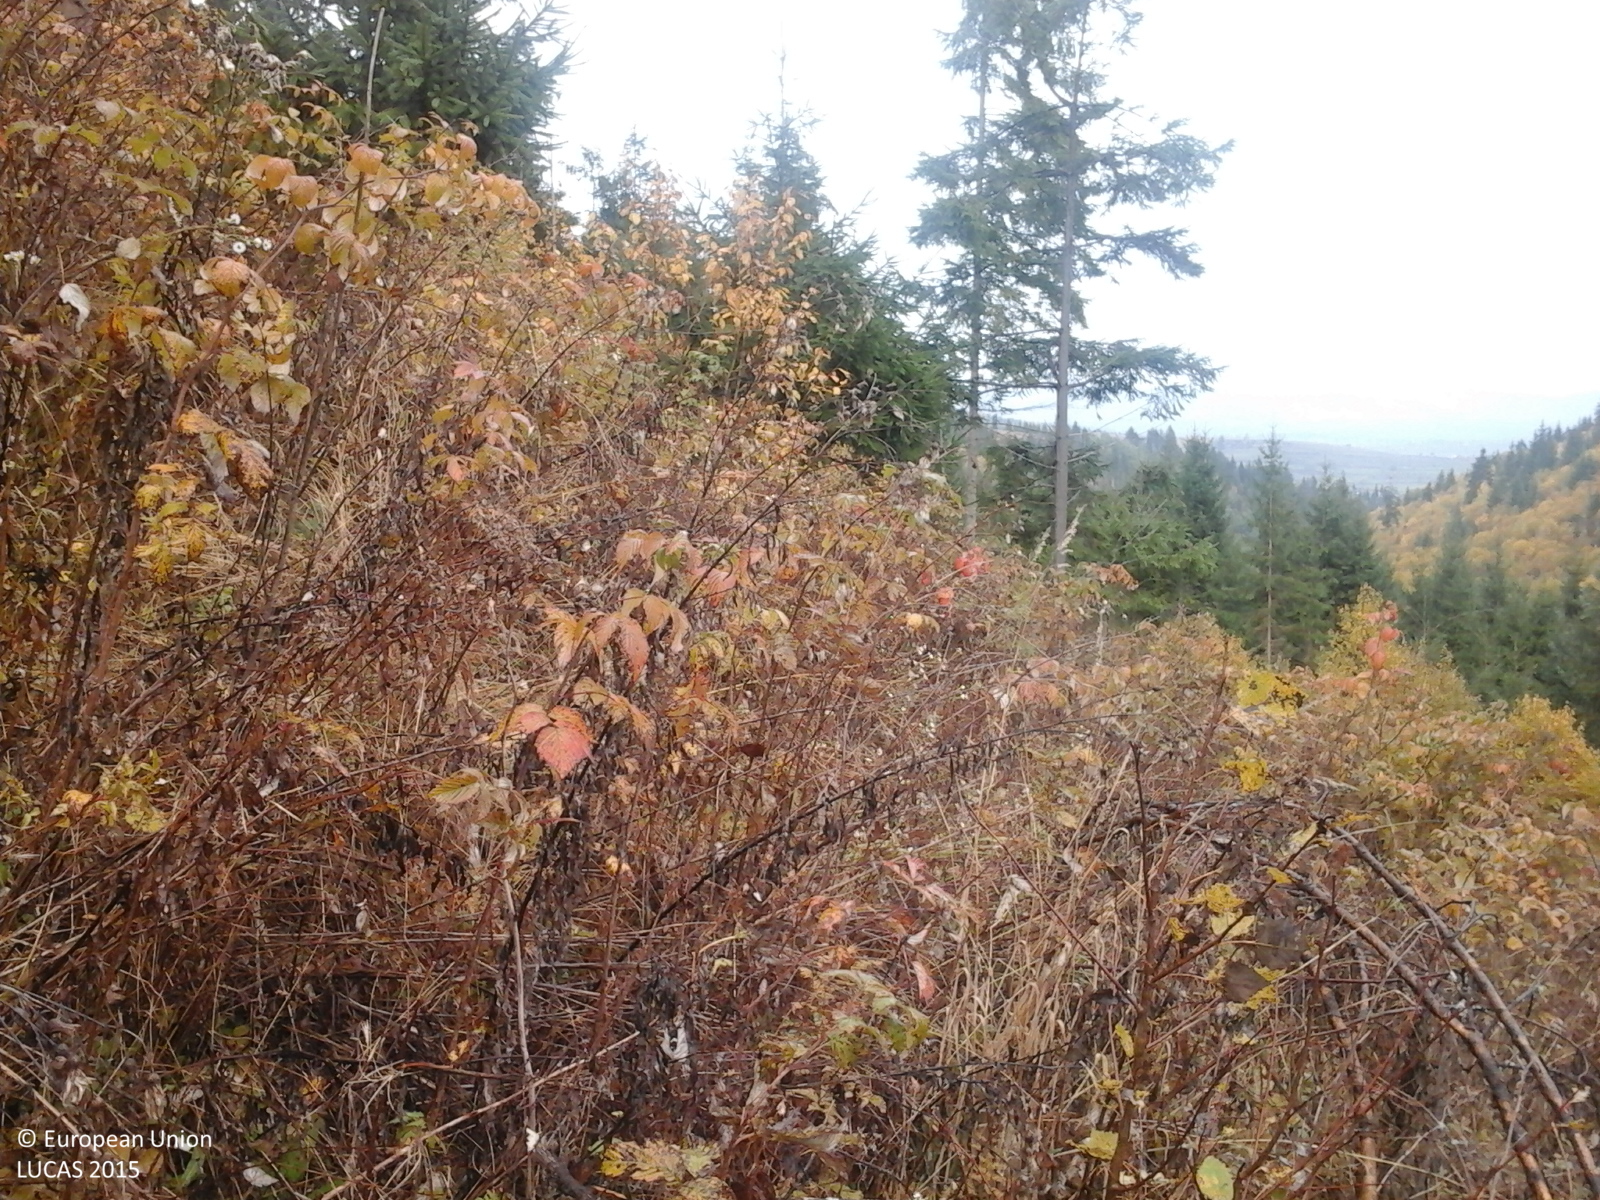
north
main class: Woodland
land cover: Spruce dominated coniferous woodland
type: alpine coniferous forest
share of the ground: 10 - 25 %
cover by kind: coniferous forest trees 100 %
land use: Forestry
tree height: > 5 m
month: October
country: RO
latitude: 46.9271
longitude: 25.3026
